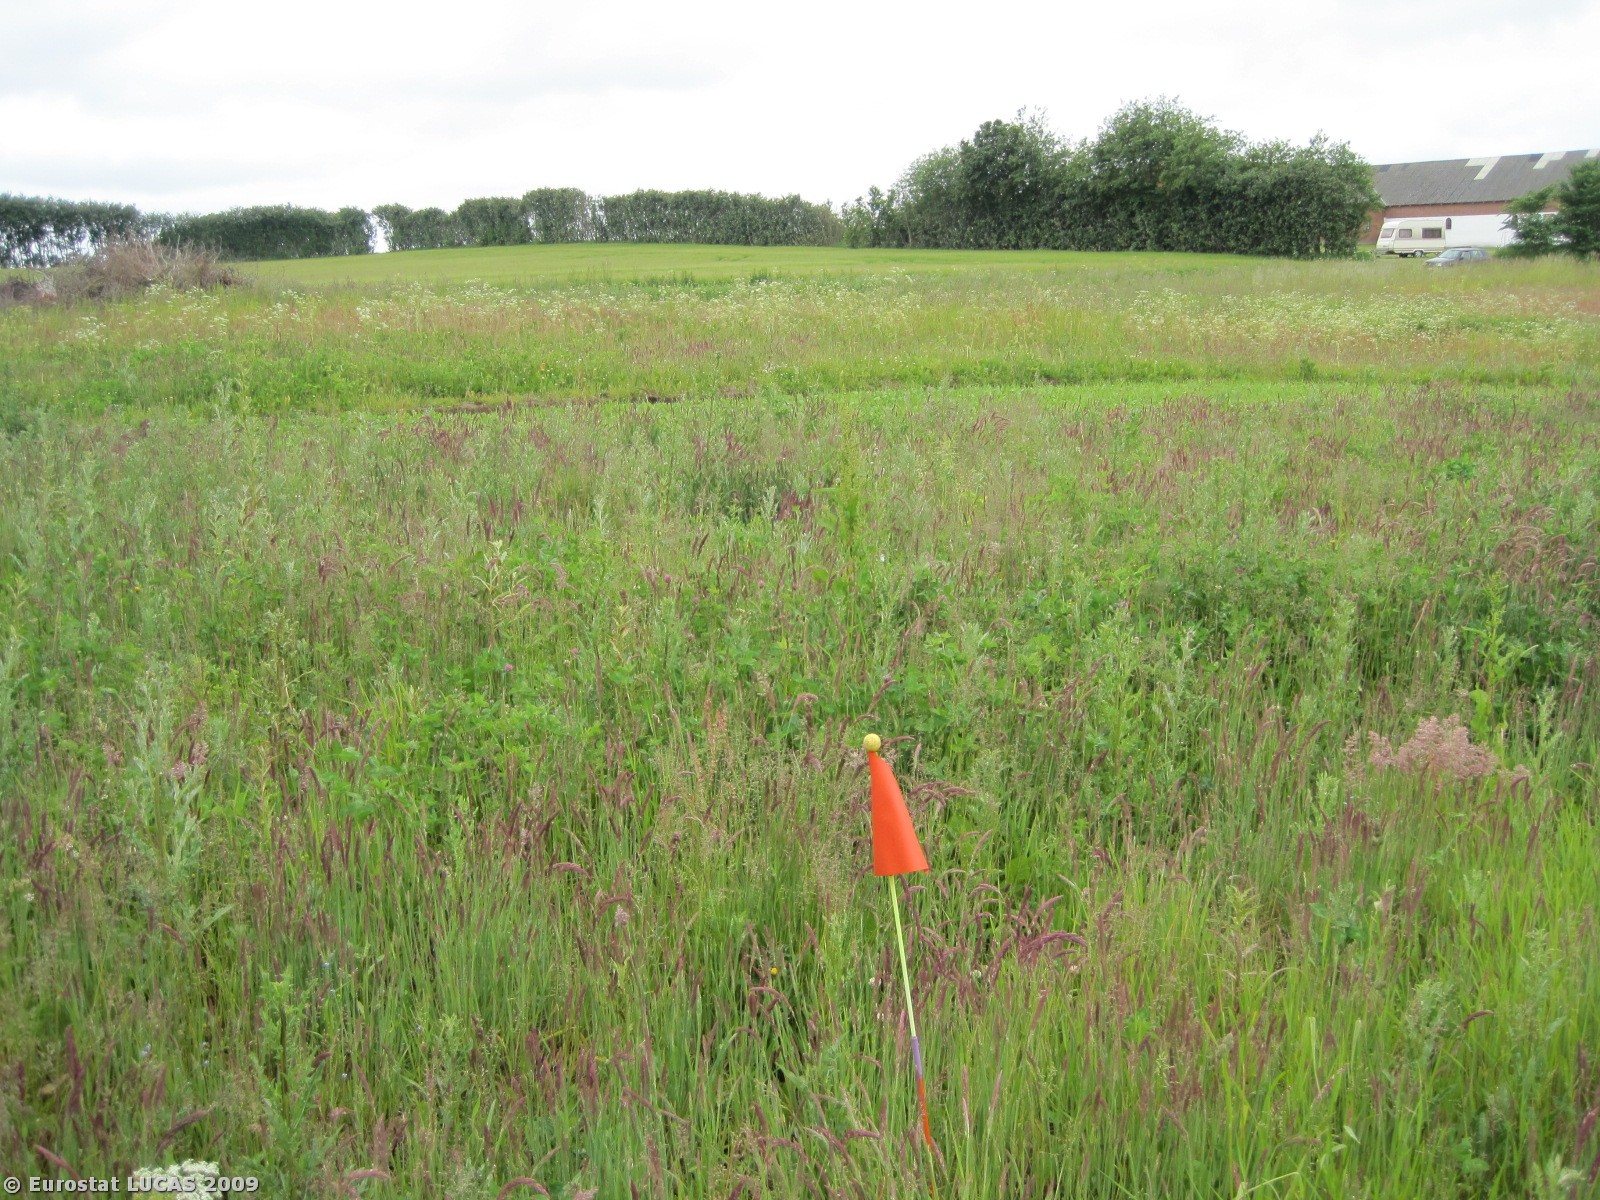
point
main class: Grassland
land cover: Grassland without tree/shrub cover
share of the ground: > 75 %
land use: Unused
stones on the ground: < 10 %
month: June
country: DK
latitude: 57.2124
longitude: 10.1157
